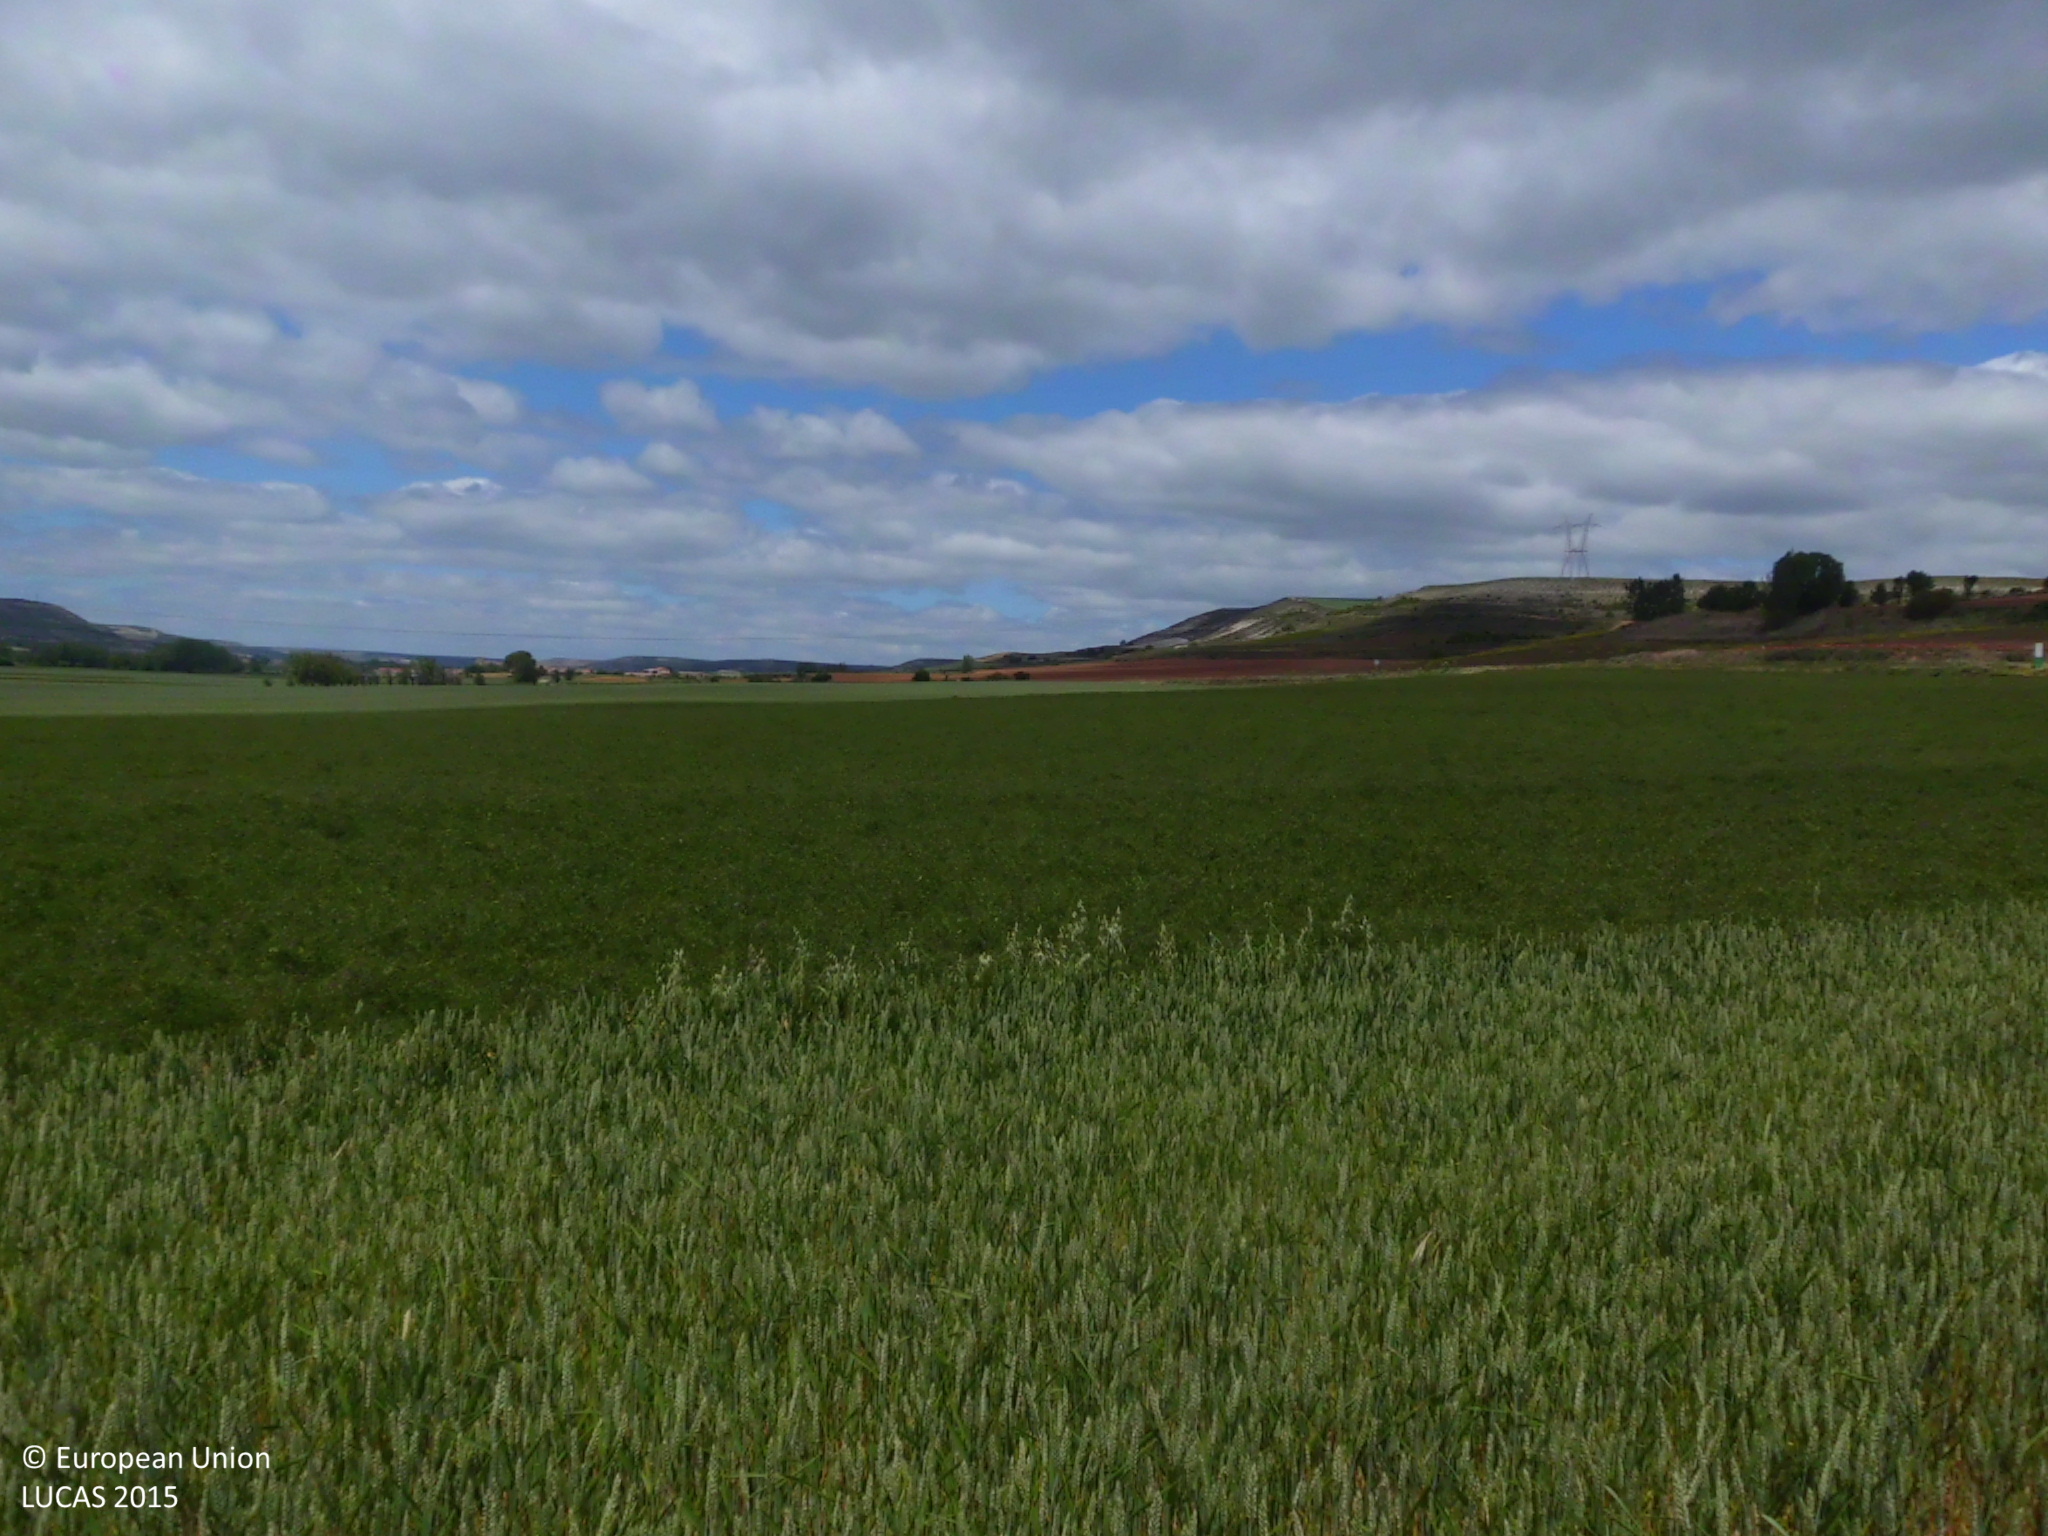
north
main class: Cropland
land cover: Common wheat
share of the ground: > 75 %
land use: Agriculture (excluding fallow land and kitchen gardens)
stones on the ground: 25 - 50 %
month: May
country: ES
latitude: 42.2939
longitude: -3.9020
